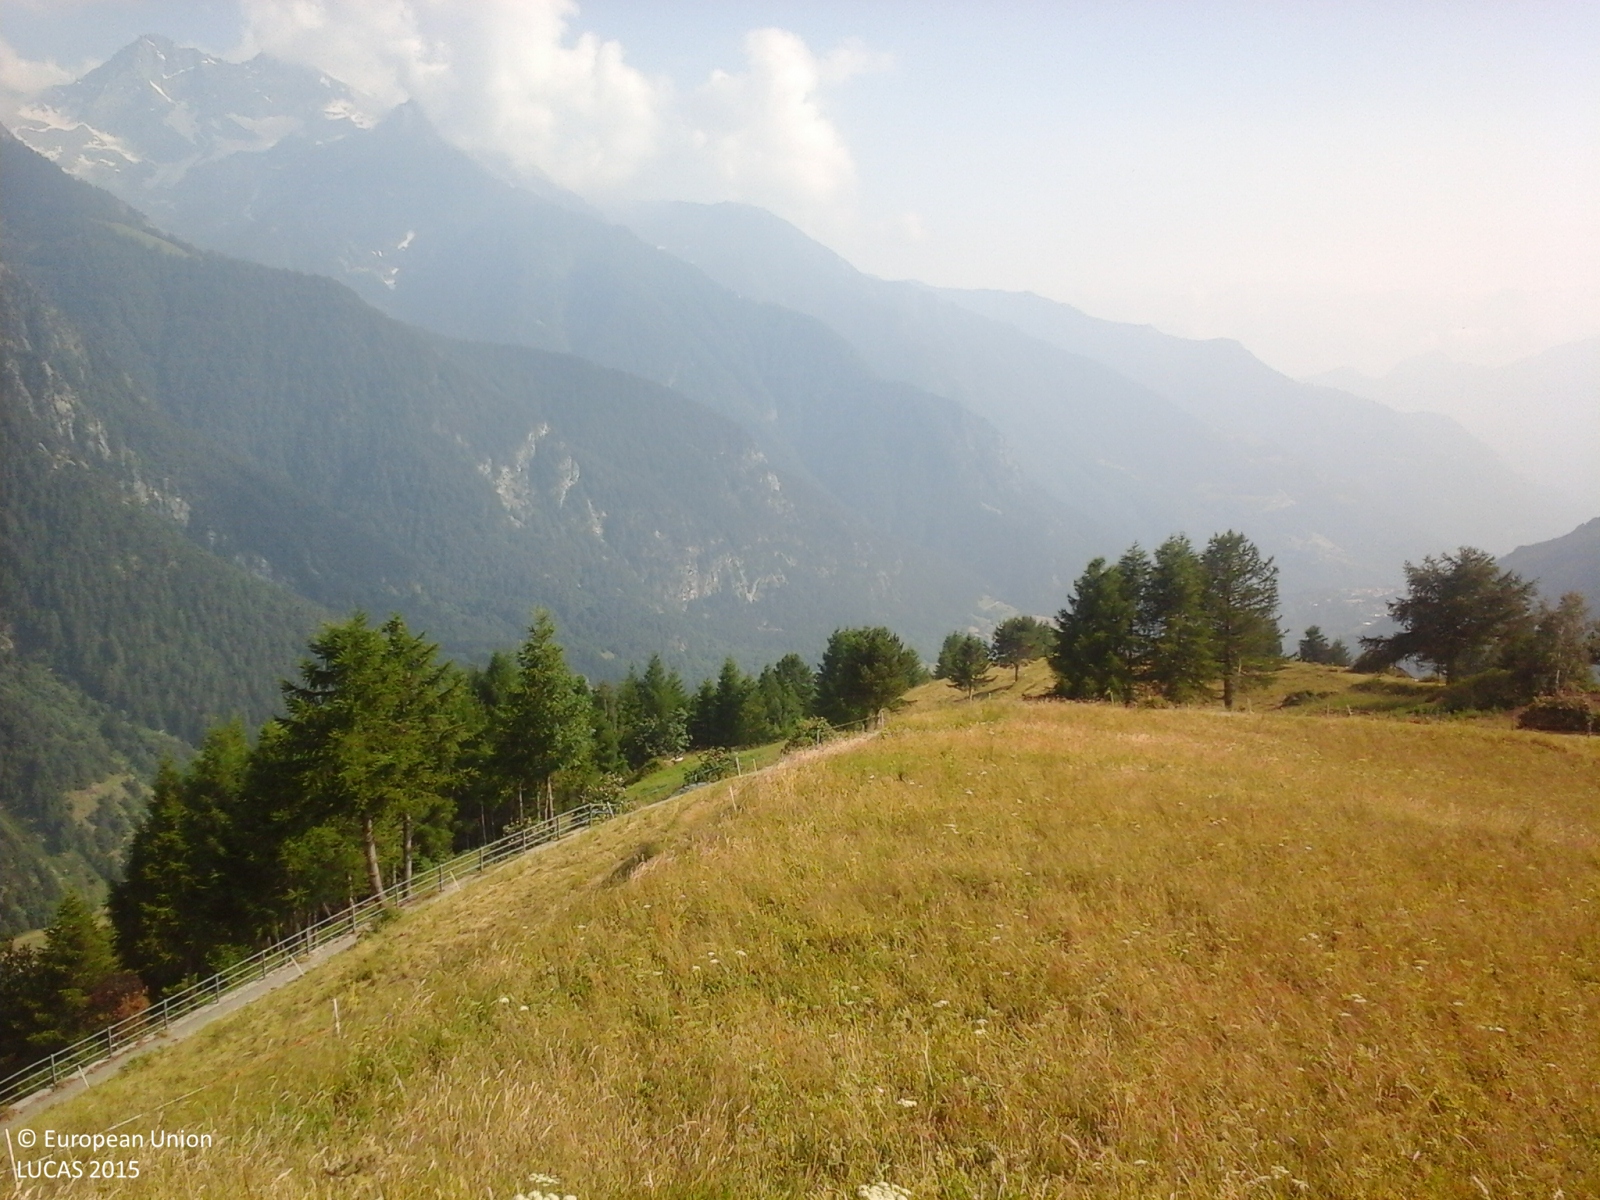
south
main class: Grassland
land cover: Grassland without tree/shrub cover
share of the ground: > 75 %
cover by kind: herbaceous plants 100 %
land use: Agriculture (excluding fallow land and kitchen gardens)
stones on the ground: < 10 %
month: July
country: IT
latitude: 45.7509
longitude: 7.7536
